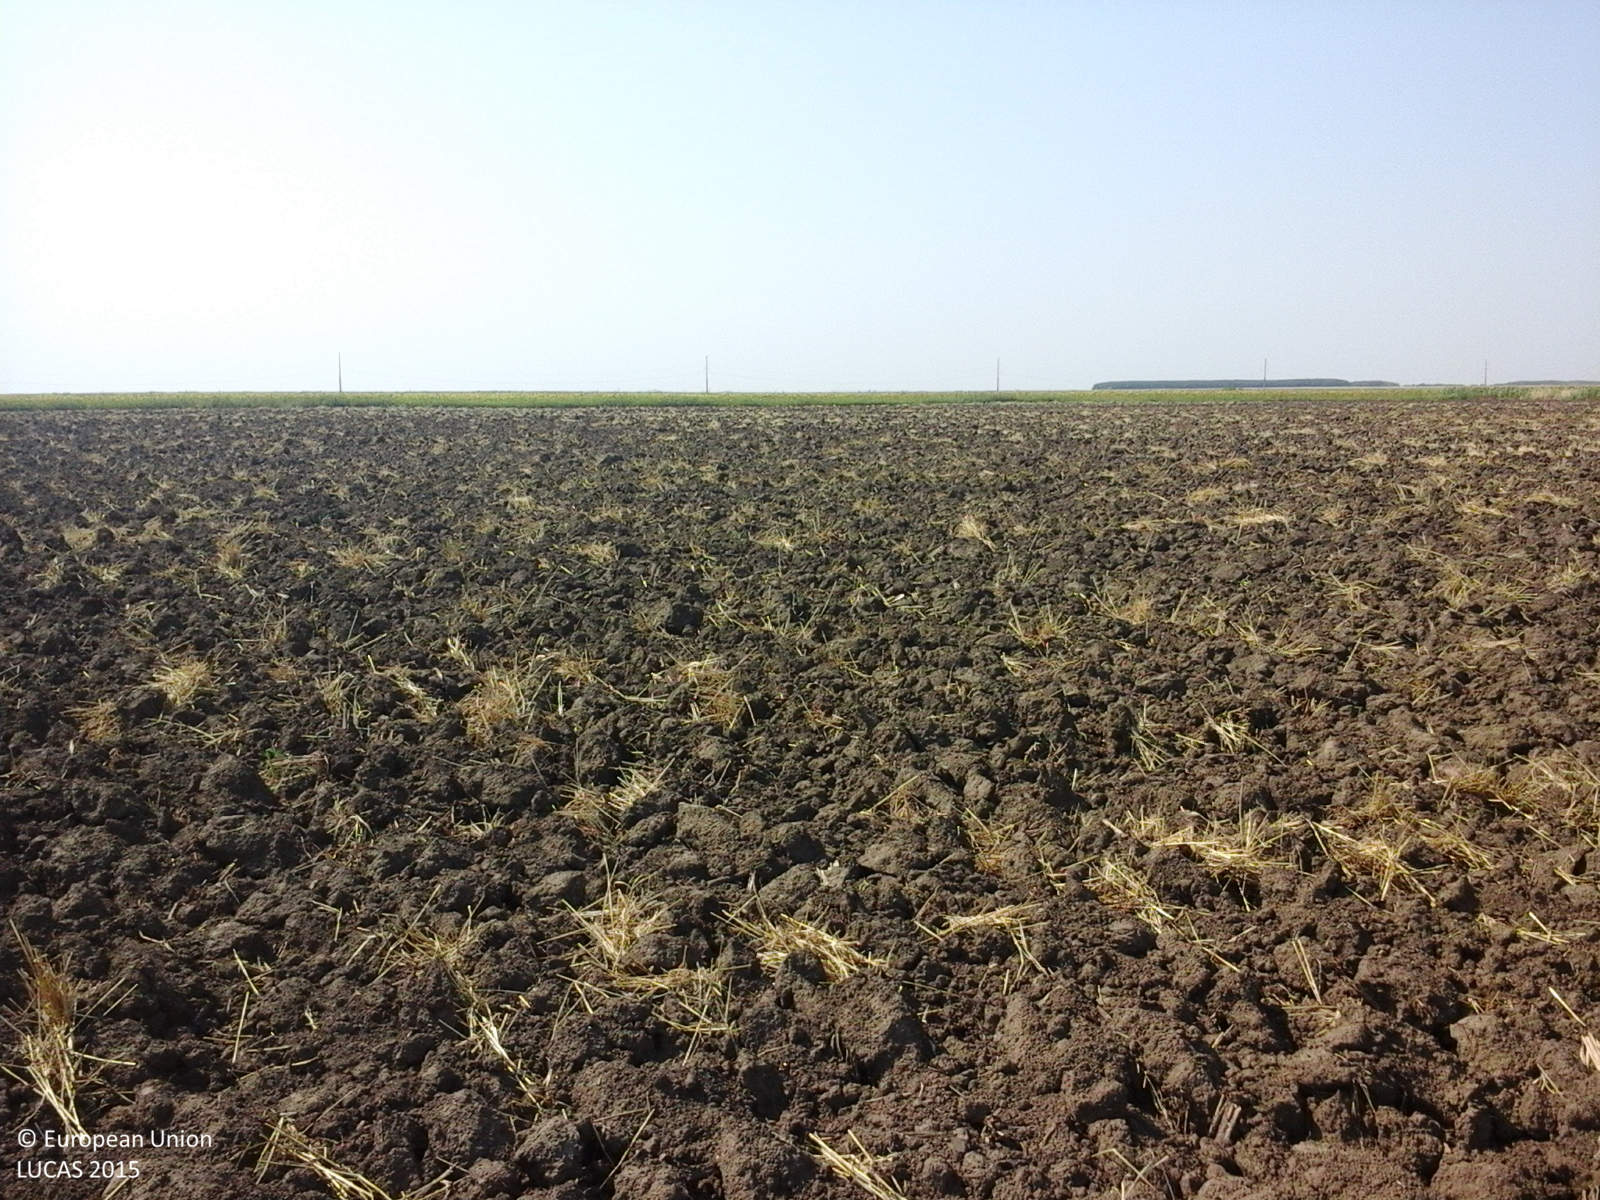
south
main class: Cropland
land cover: Common wheat
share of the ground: < 10 %
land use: Agriculture (excluding fallow land and kitchen gardens)
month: August
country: RO
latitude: 45.0834
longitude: 27.3595
